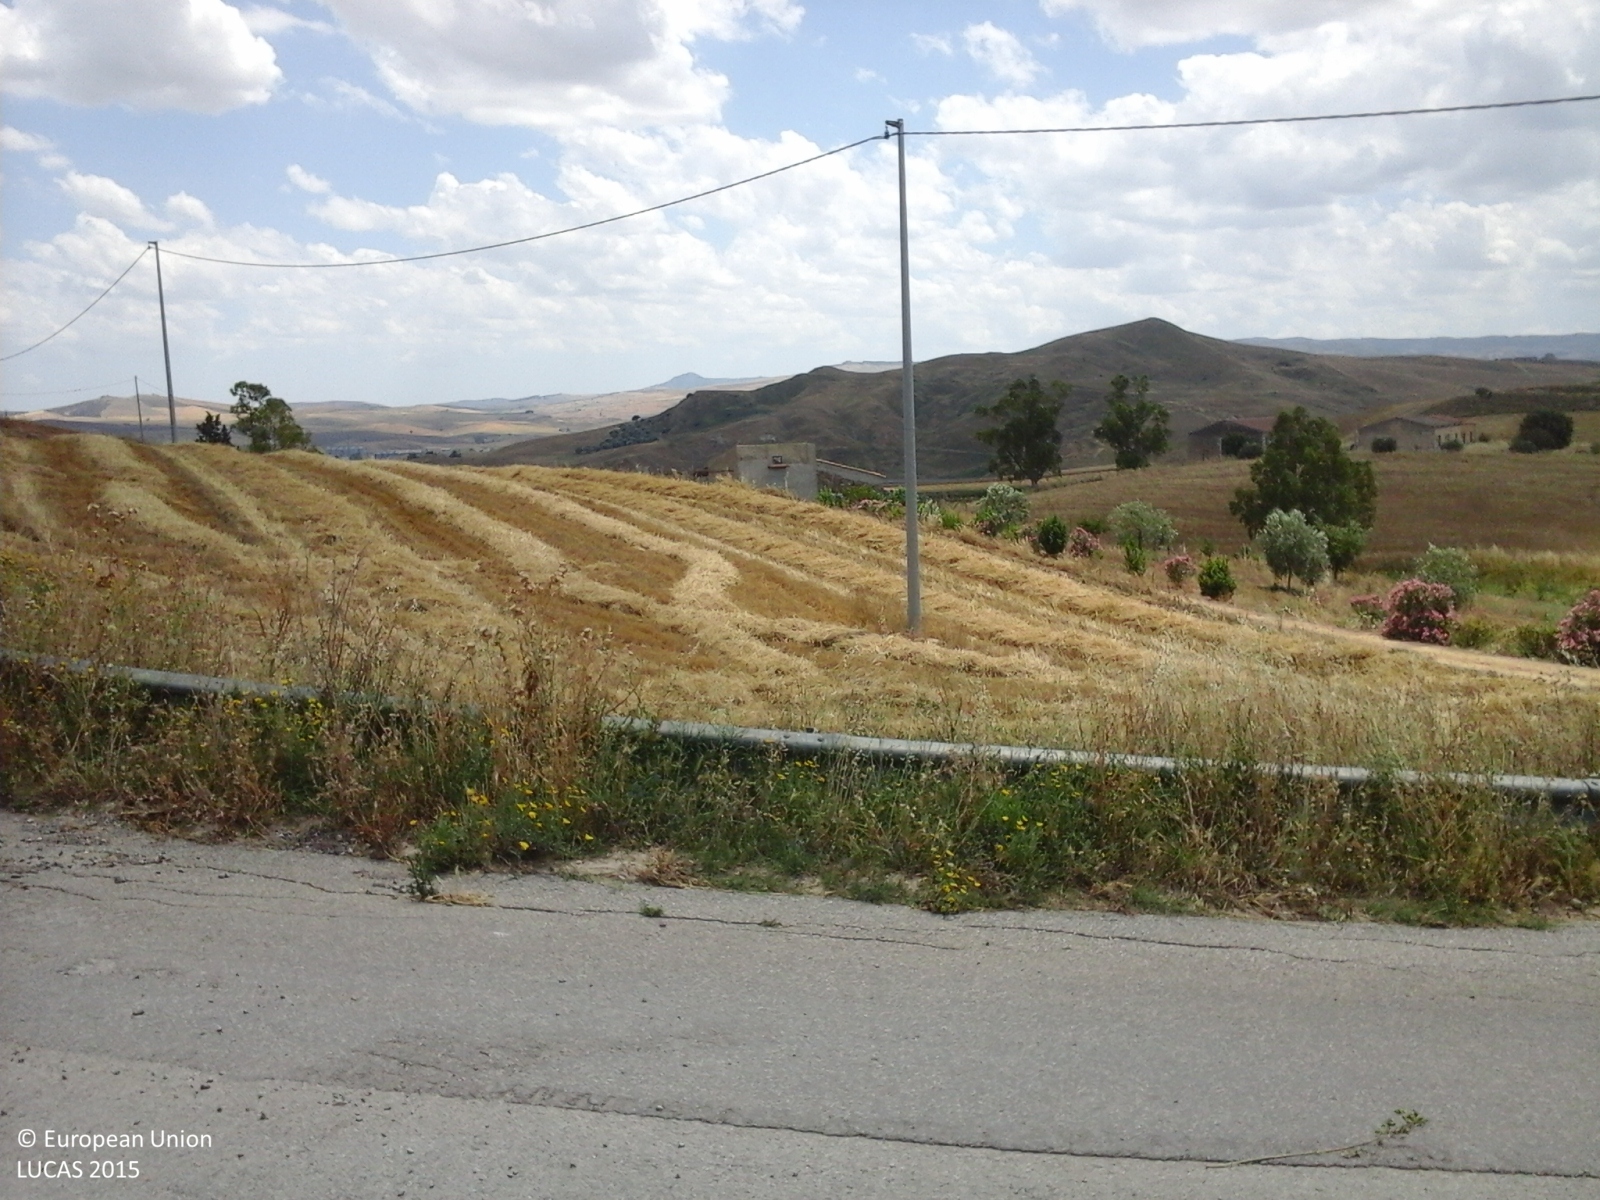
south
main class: Cropland
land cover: Durum wheat
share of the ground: > 75 %
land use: Agriculture (excluding fallow land and kitchen gardens)
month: June
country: IT
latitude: 37.5892
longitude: 14.4411
